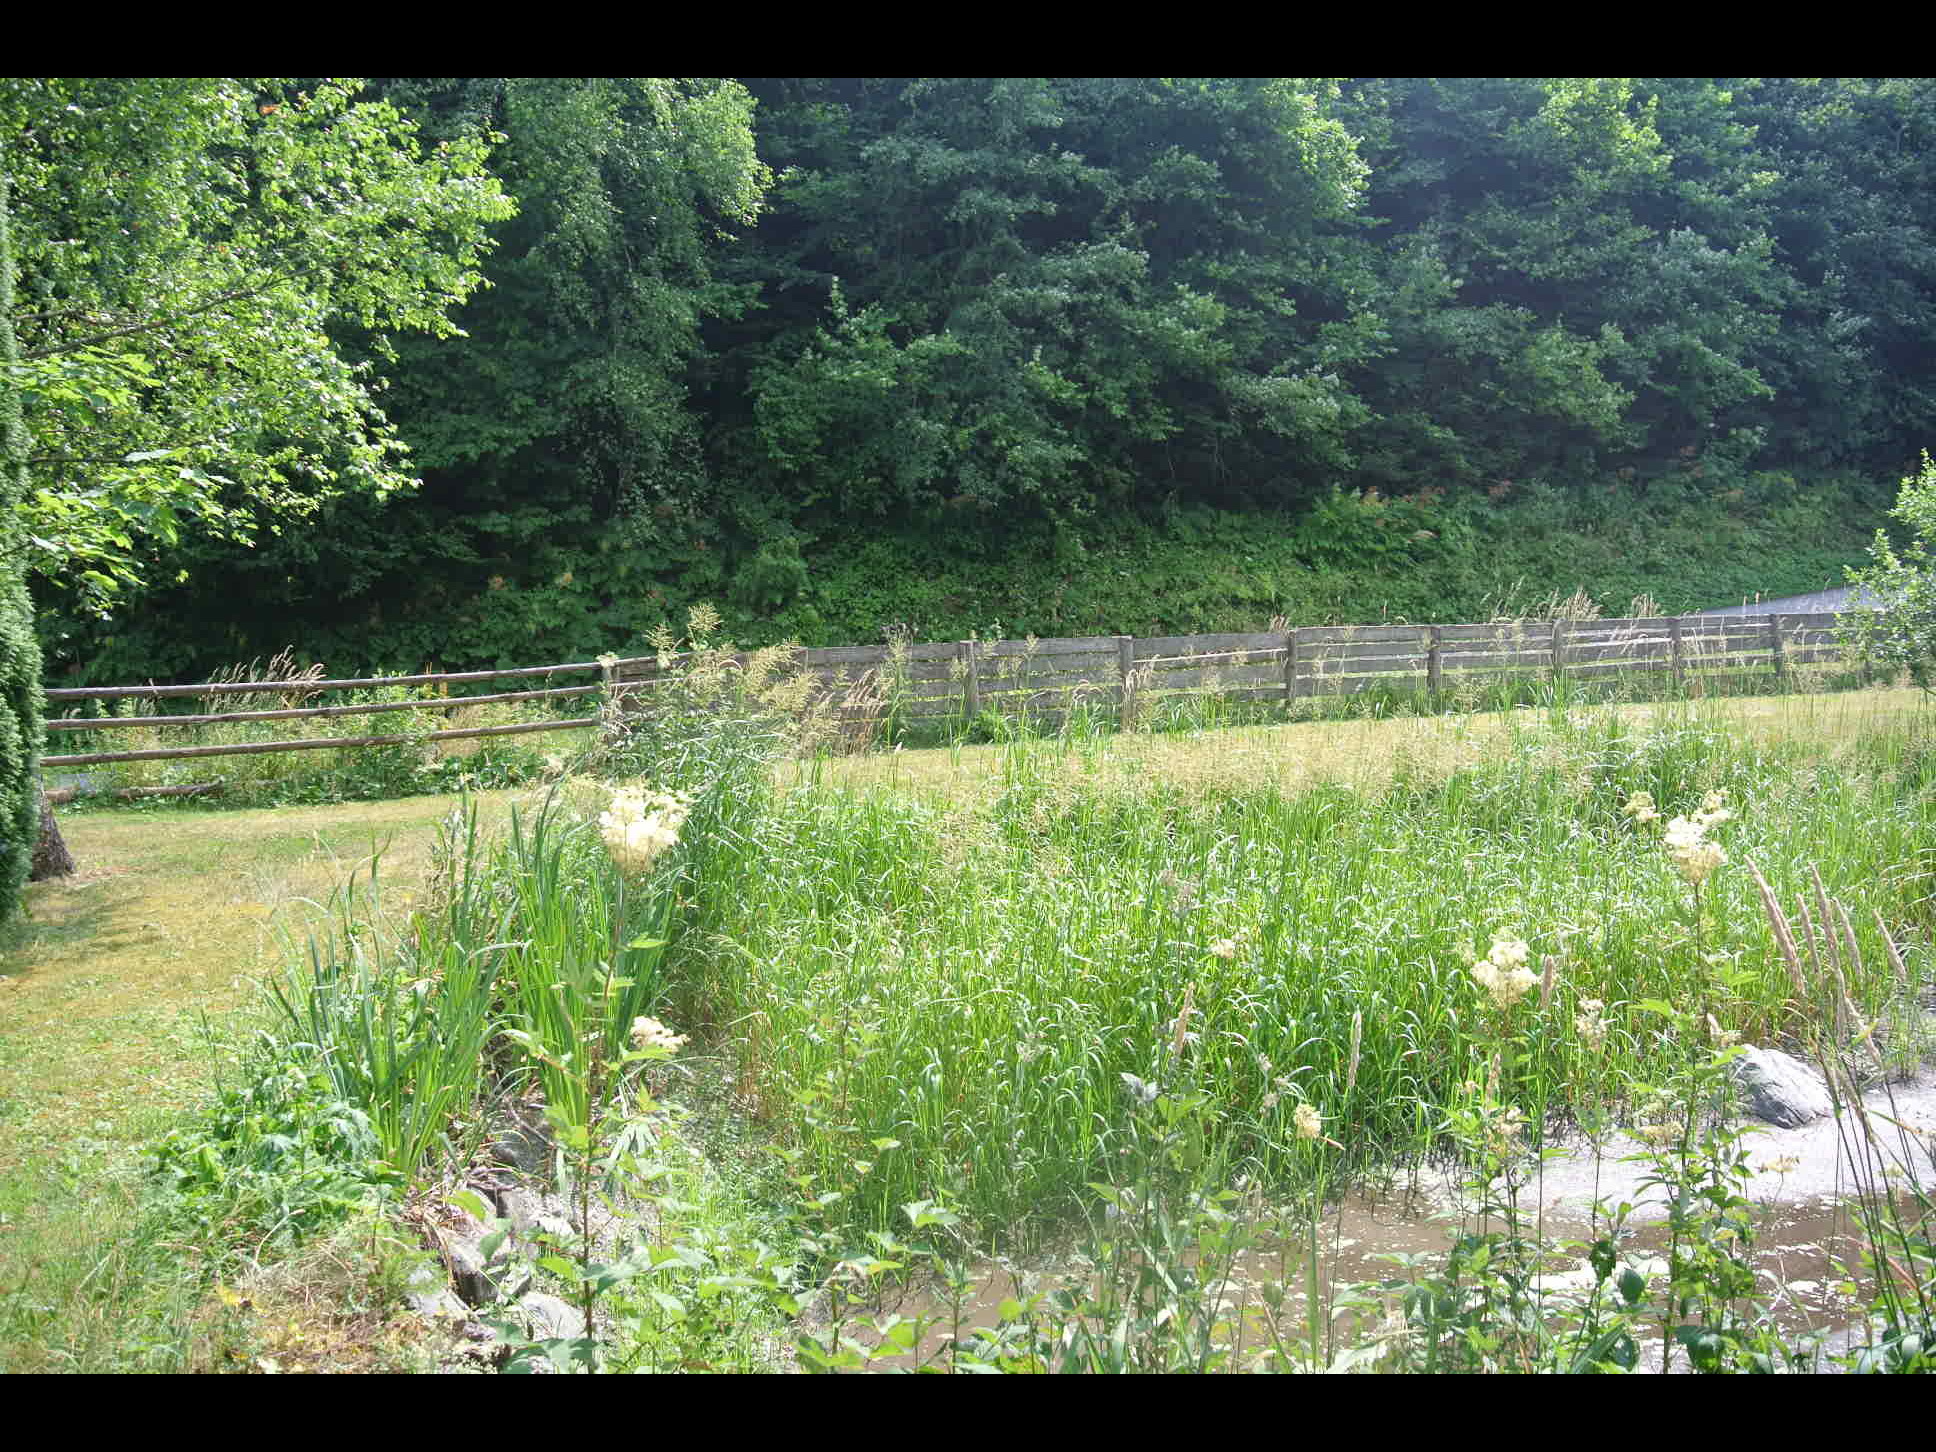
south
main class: Grassland
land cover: Grassland with sparse tree/shrub cover
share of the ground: > 75 %
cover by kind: herbaceous plants 90 %, broadleaved forest trees 5 %, shrubs 5 %
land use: Amenities, museums, leisure
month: July
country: AT
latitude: 47.5522
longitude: 16.0487
